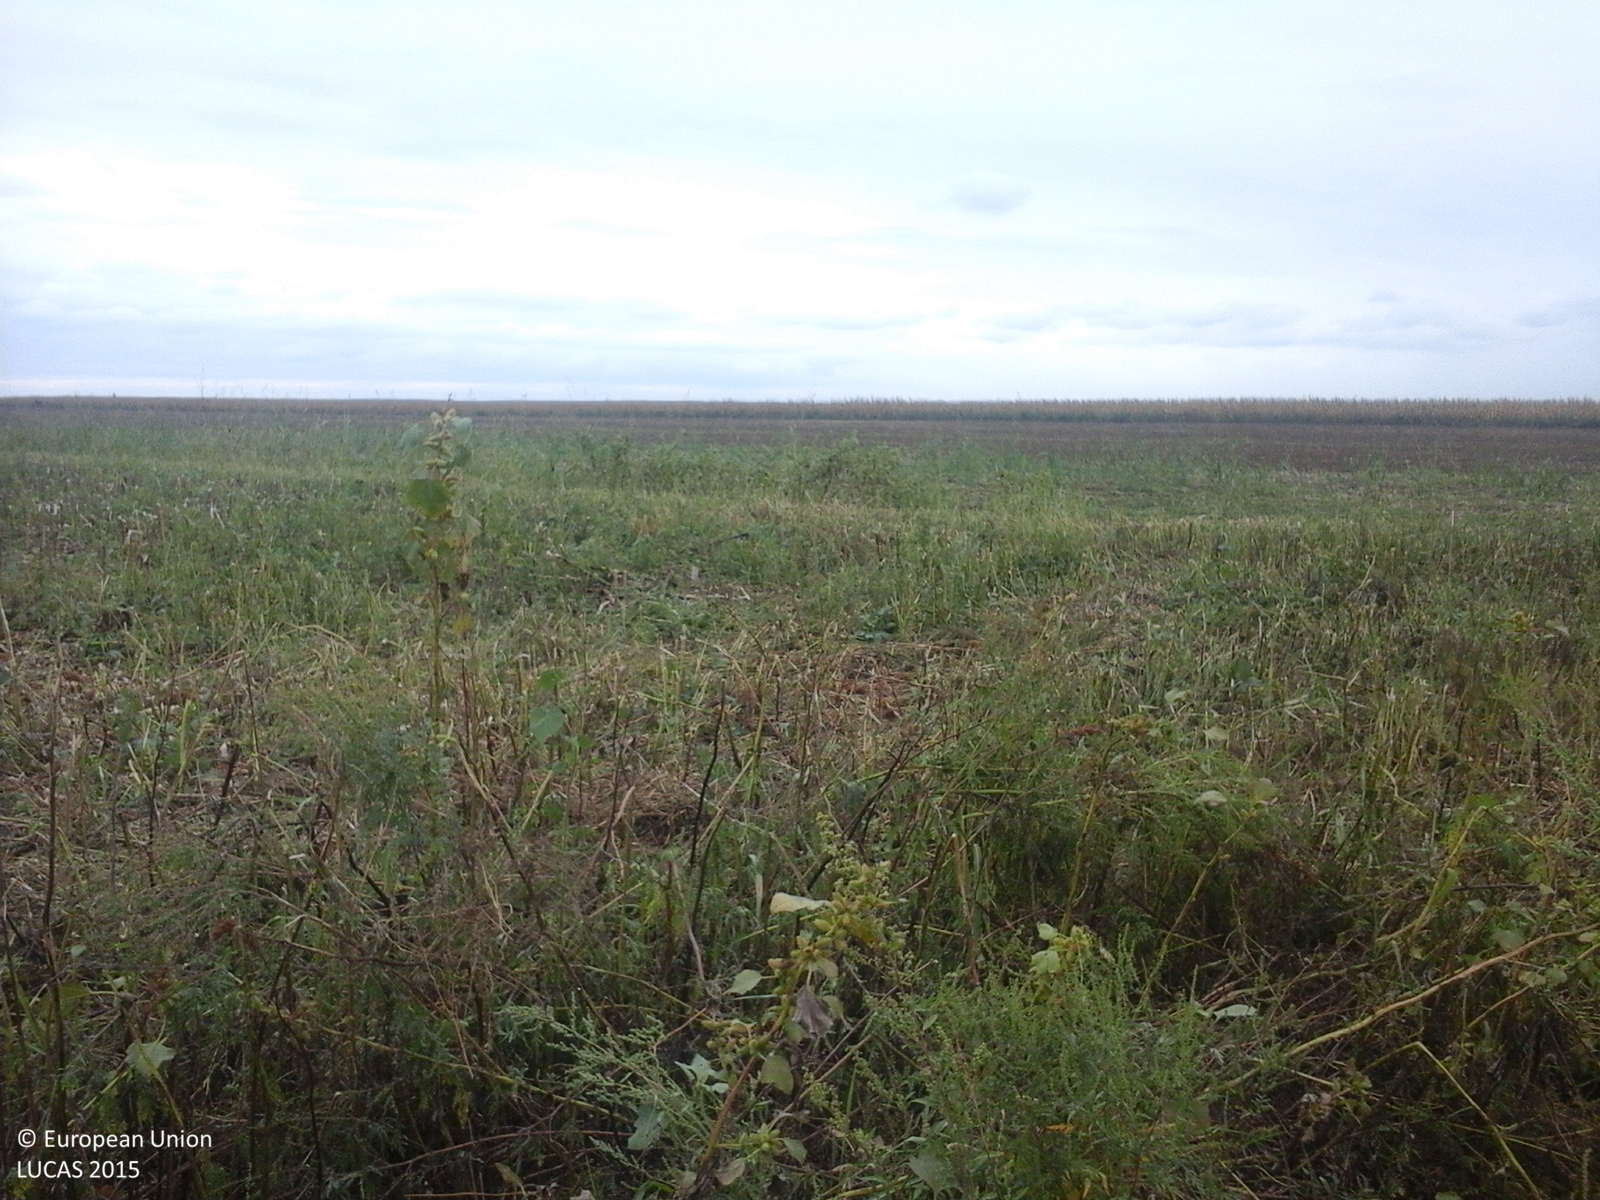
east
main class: Cropland
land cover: Soya
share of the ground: > 75 %
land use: Agriculture (excluding fallow land and kitchen gardens)
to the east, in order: Soya; Shruby margins; Maize; Sunflower
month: September
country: RO
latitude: 47.3704
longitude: 21.9535
